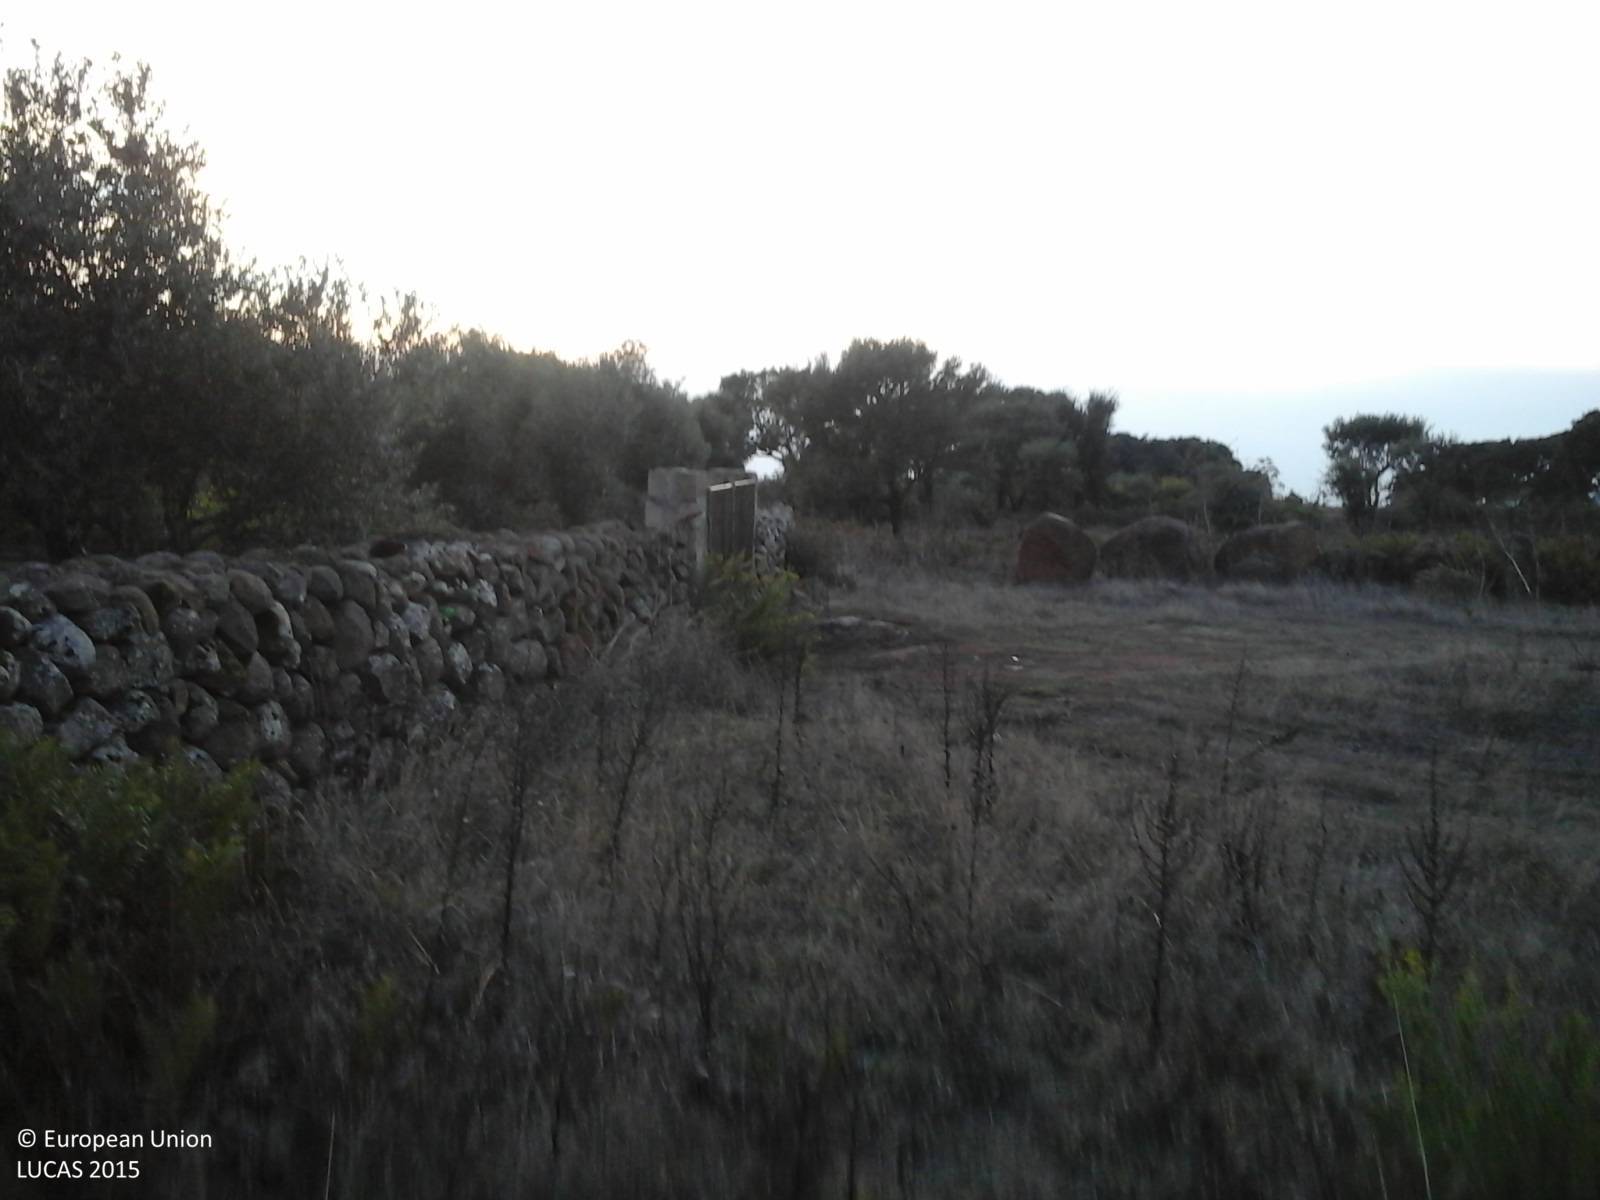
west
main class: Grassland
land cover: Spontaneously vegetated surfaces
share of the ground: > 75 %
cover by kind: herbaceous plants 100 %
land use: Agriculture (excluding fallow land and kitchen gardens)
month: October
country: IT
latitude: 40.2752
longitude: 8.5843
